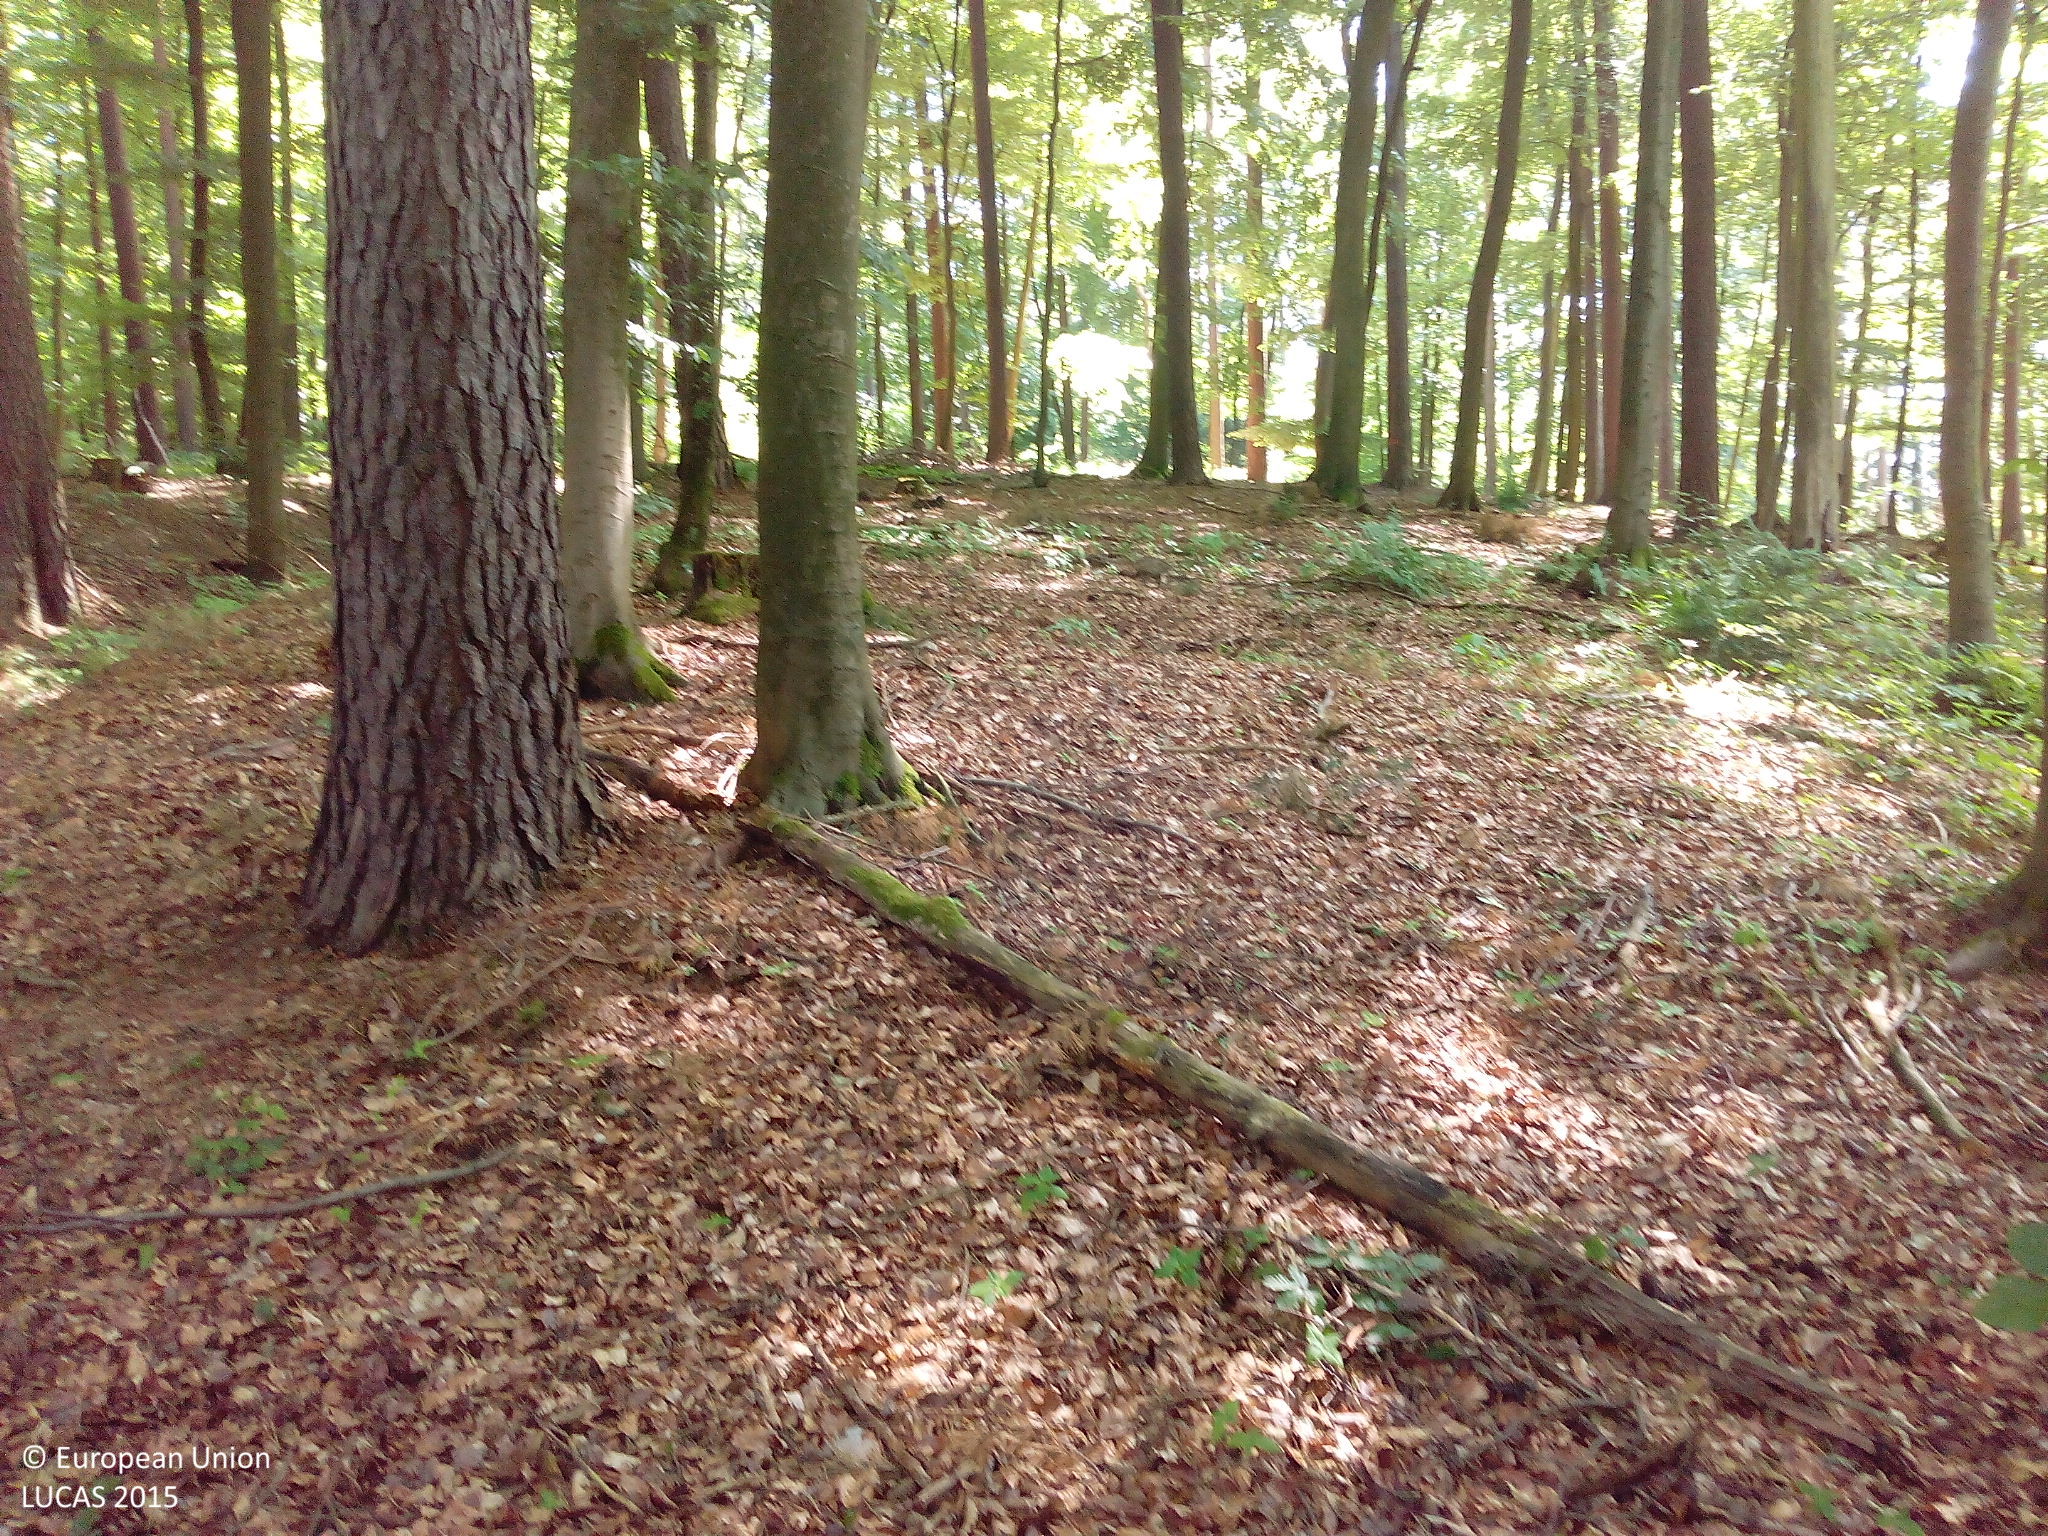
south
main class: Woodland
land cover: Pine dominated mixed woodland
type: hemiboreal forest and nemoral coniferous forest and mixed broadleaved-coniferous forest
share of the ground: > 75 %
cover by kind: broadleaved forest trees 60 %, coniferous forest trees 25 %, unconsolidated bare surface 10 %, shrubs 5 %
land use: Forestry
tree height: > 5 m
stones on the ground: < 10 %
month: July
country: DE
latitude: 50.9753
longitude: 9.9003
